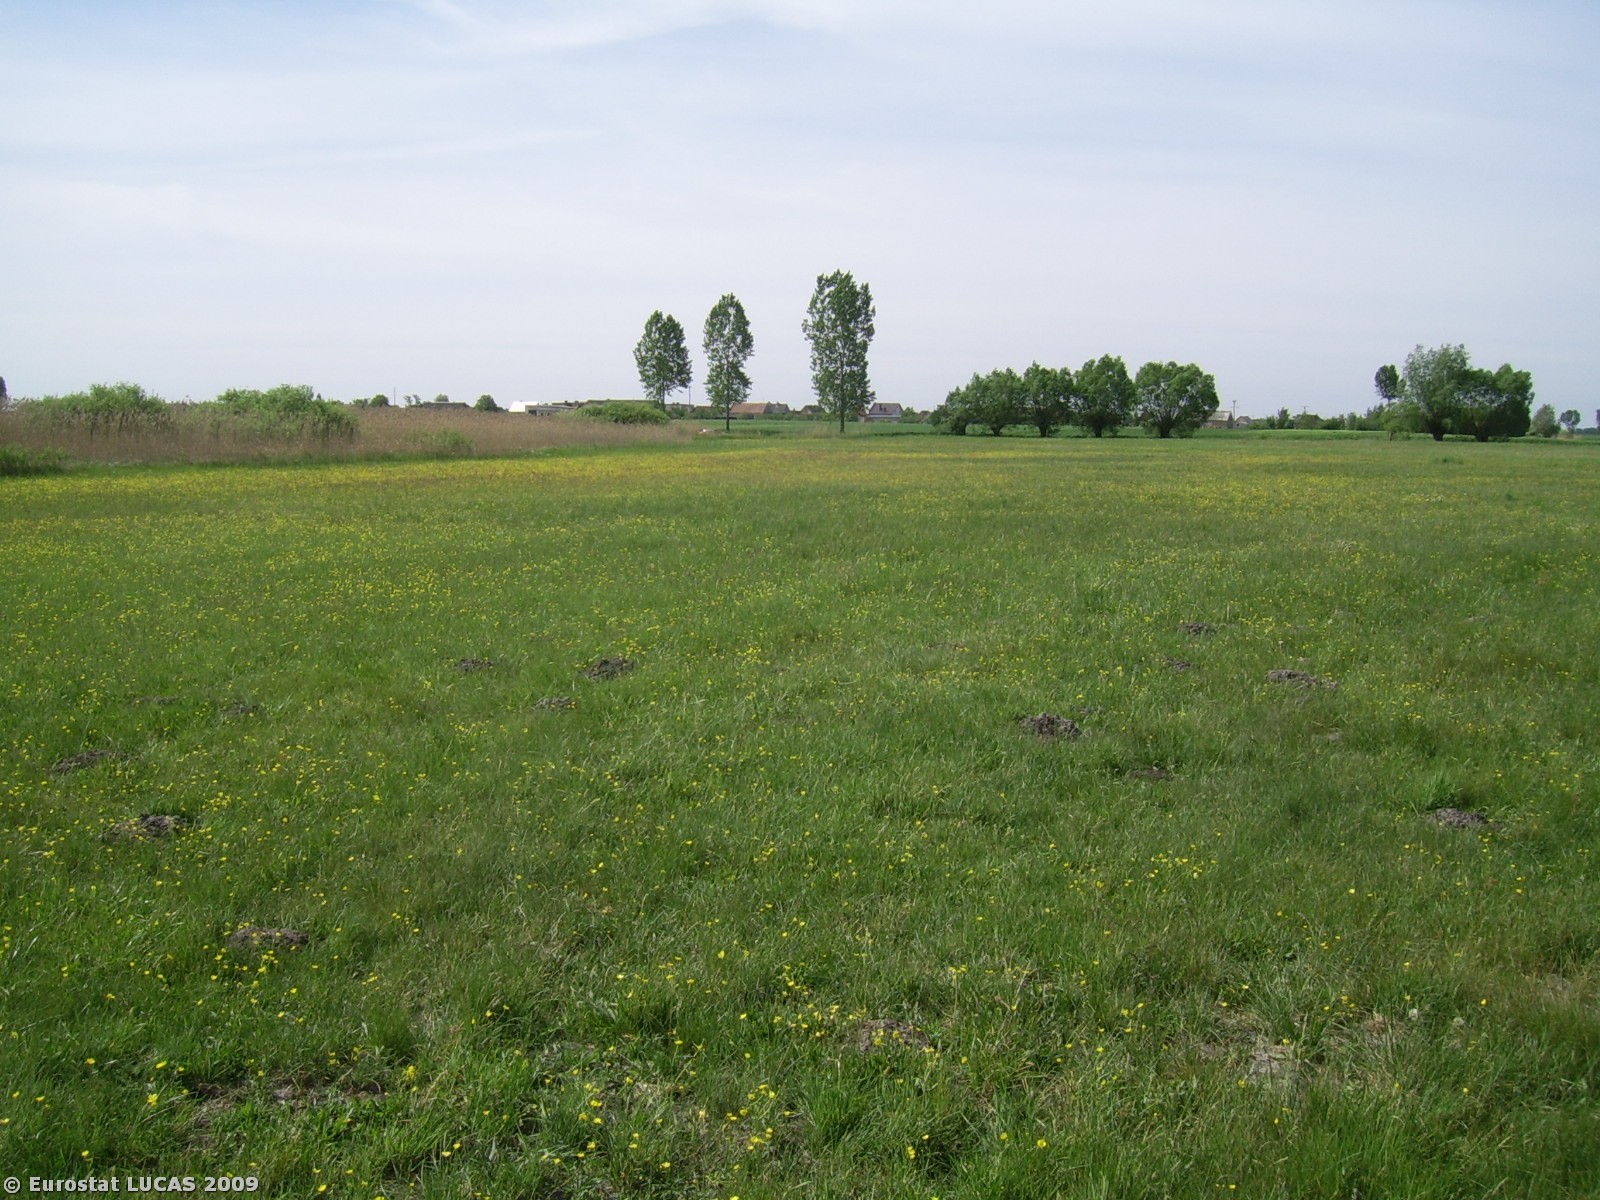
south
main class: Grassland
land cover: Grassland without tree/shrub cover
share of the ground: > 75 %
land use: Agriculture (excluding fallow land and kitchen gardens)
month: May
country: PL
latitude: 52.0142
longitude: 16.9013
